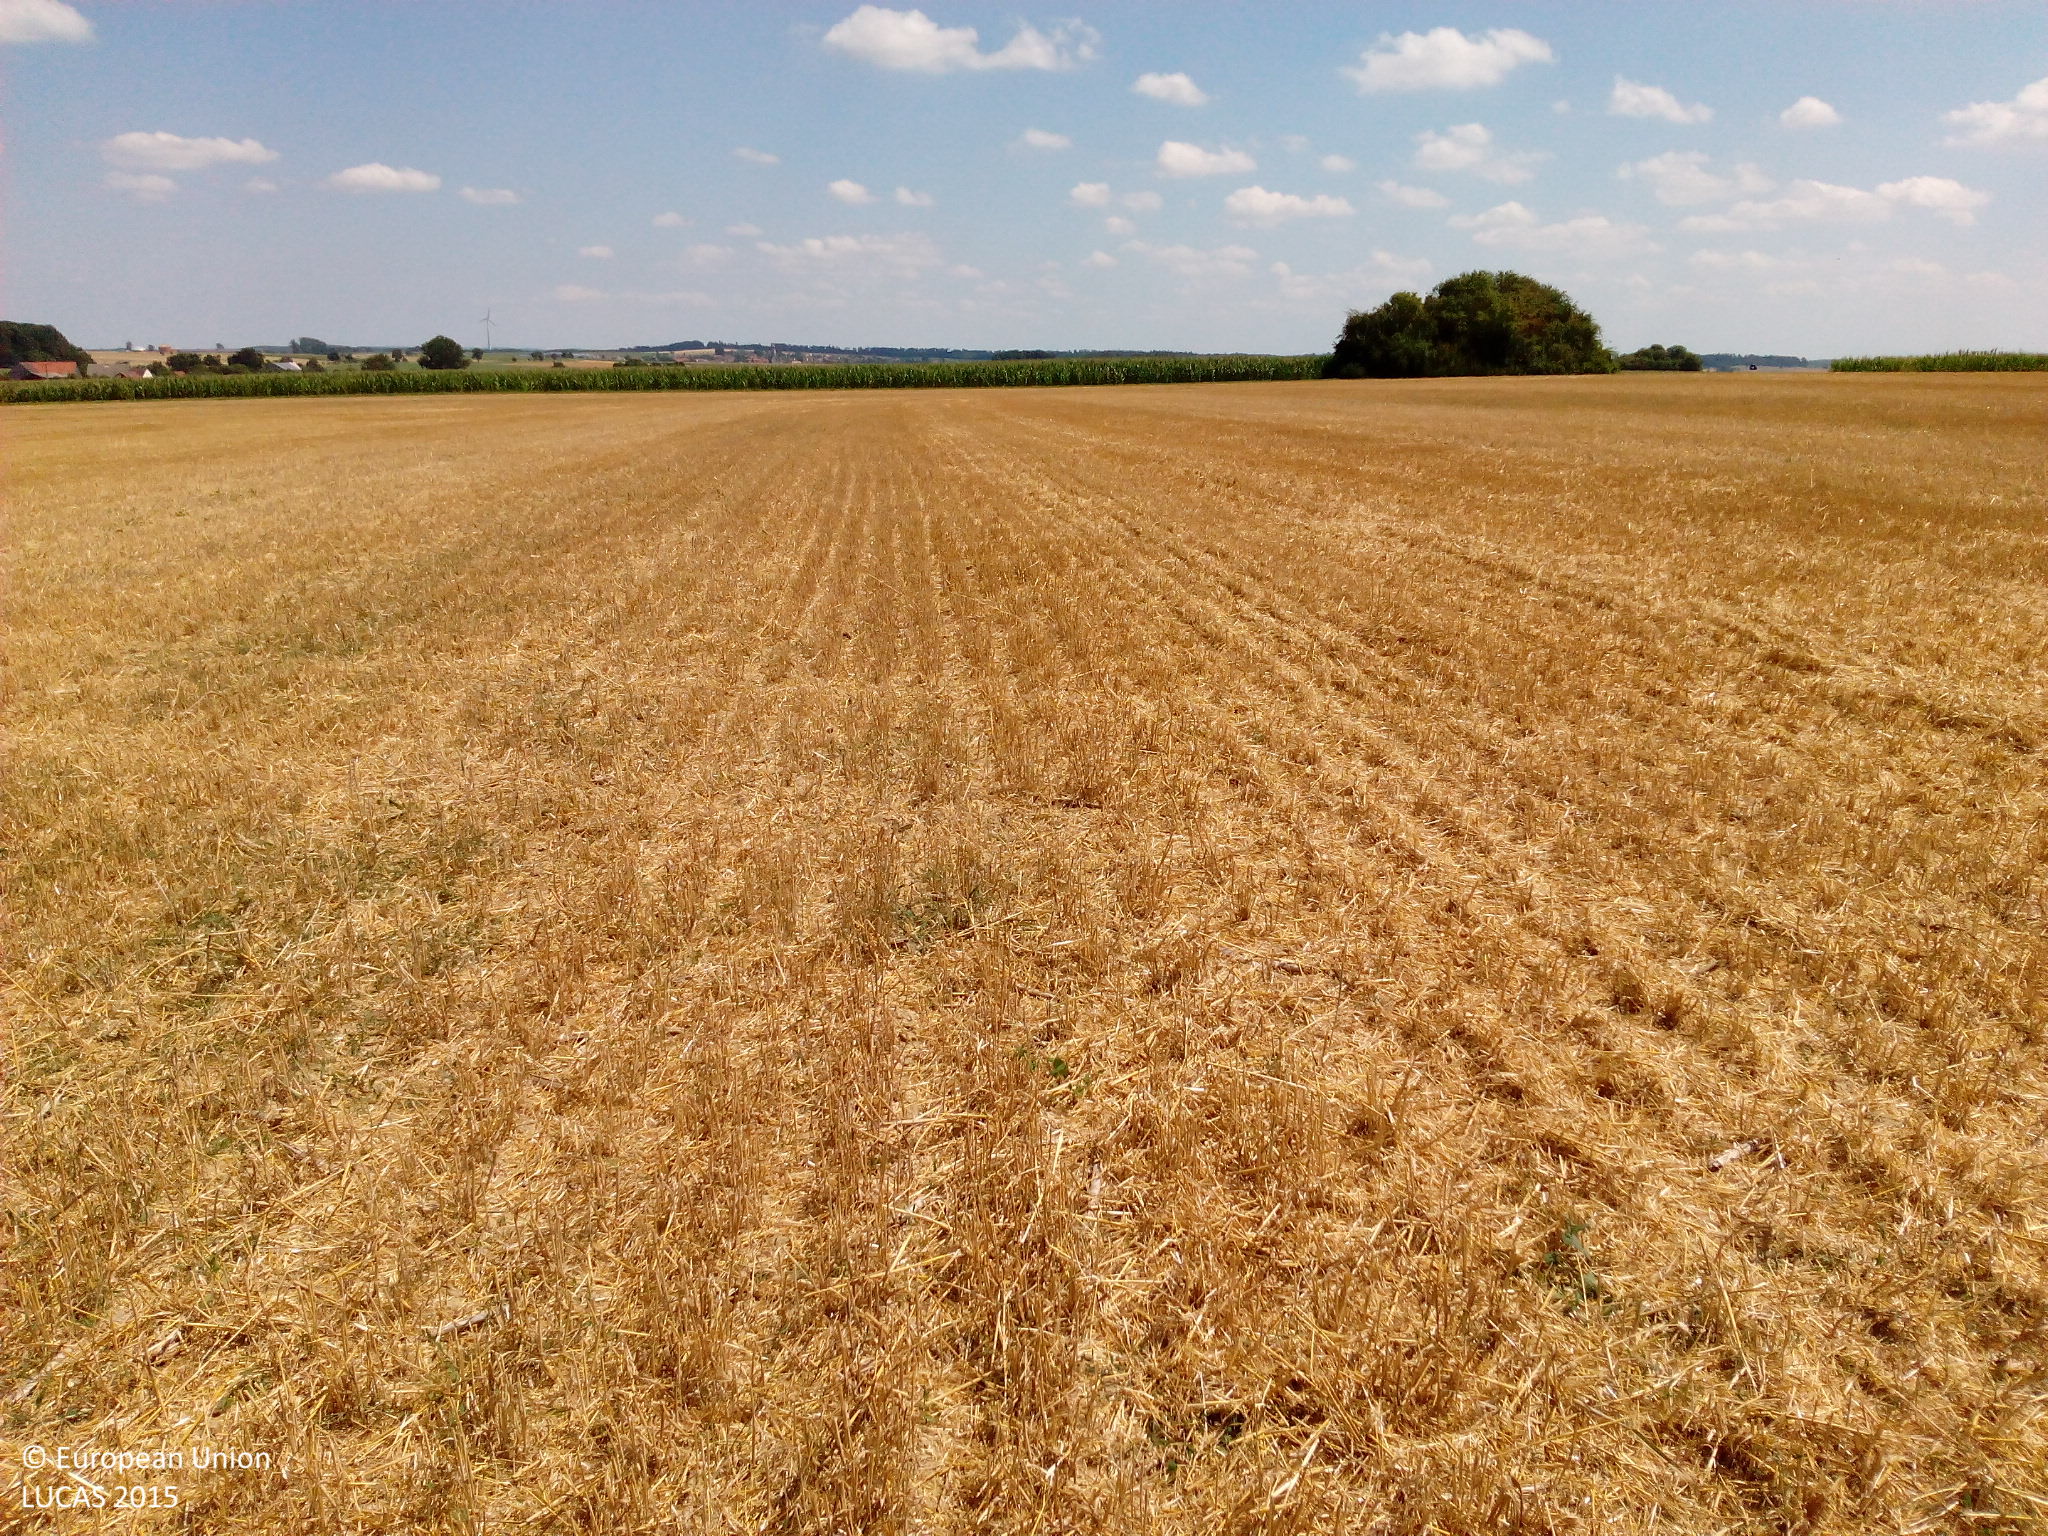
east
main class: Cropland
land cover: Common wheat
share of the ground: < 10 %
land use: Agriculture (excluding fallow land and kitchen gardens)
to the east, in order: Common wheat; Grass margins; Paved roads, cycling and walking lanes; Grass margins; Maize
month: August
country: DE
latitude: 48.9788
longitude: 10.3141
